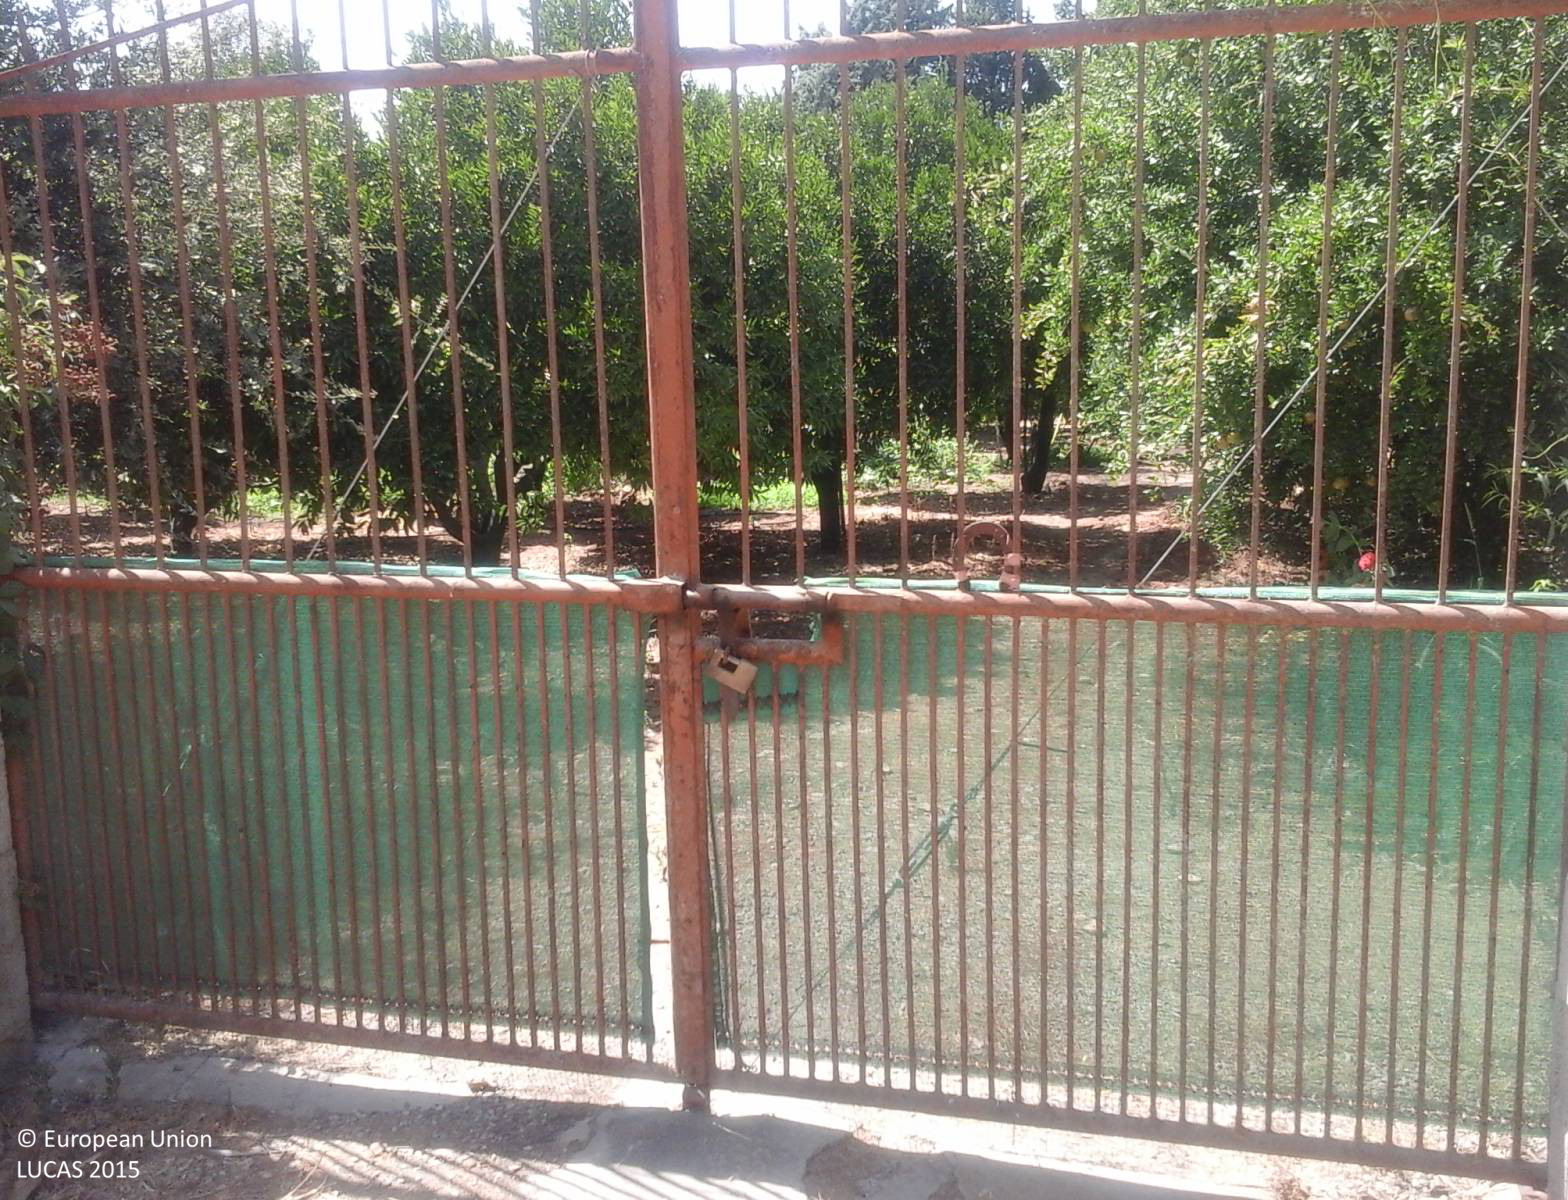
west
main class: Cropland
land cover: Oranges
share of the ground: > 75 %
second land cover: Grassland without tree/shrub cover
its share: > 75 %
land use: Agriculture (excluding fallow land and kitchen gardens)
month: August
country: IT
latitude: 39.4281
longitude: 8.9030
